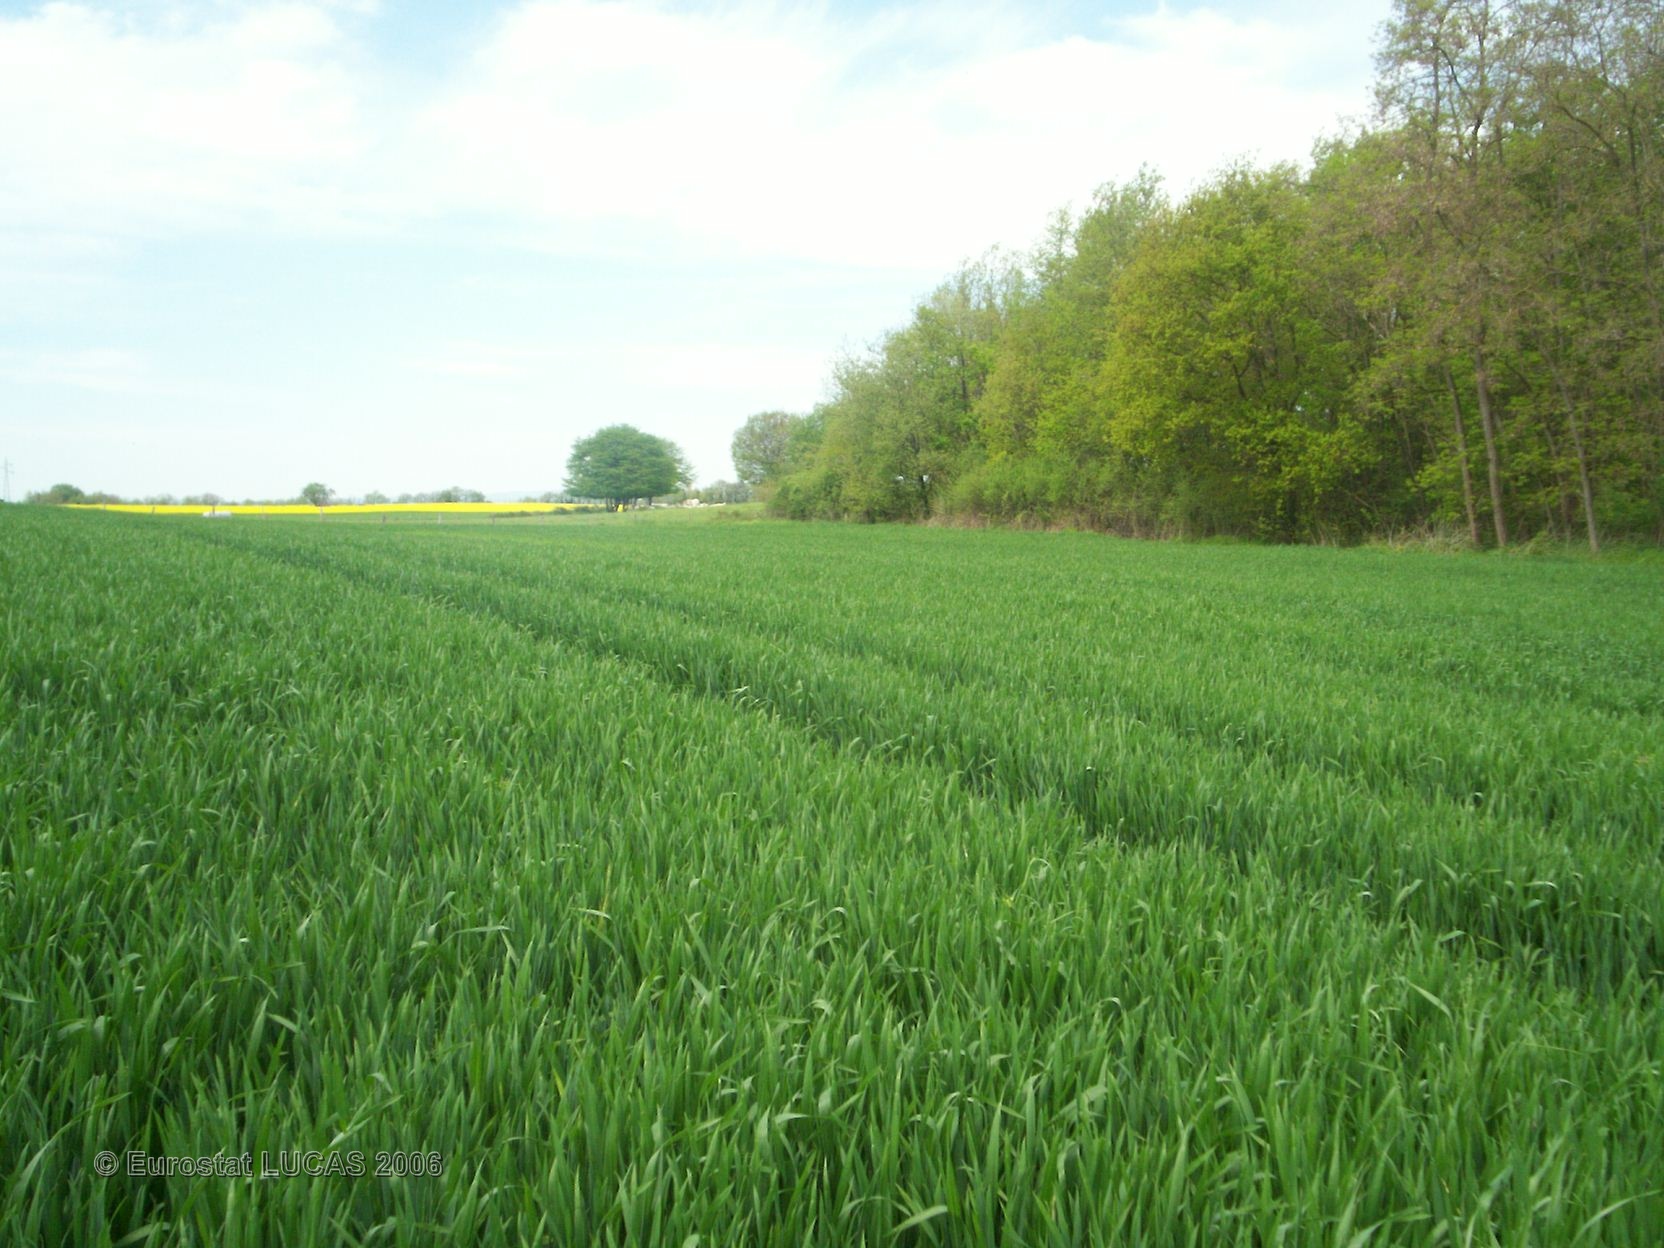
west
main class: Cropland
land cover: Common wheat
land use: Agriculture (excluding fallow land and kitchen gardens)
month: May
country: FR
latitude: 46.2441
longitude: 3.2156
